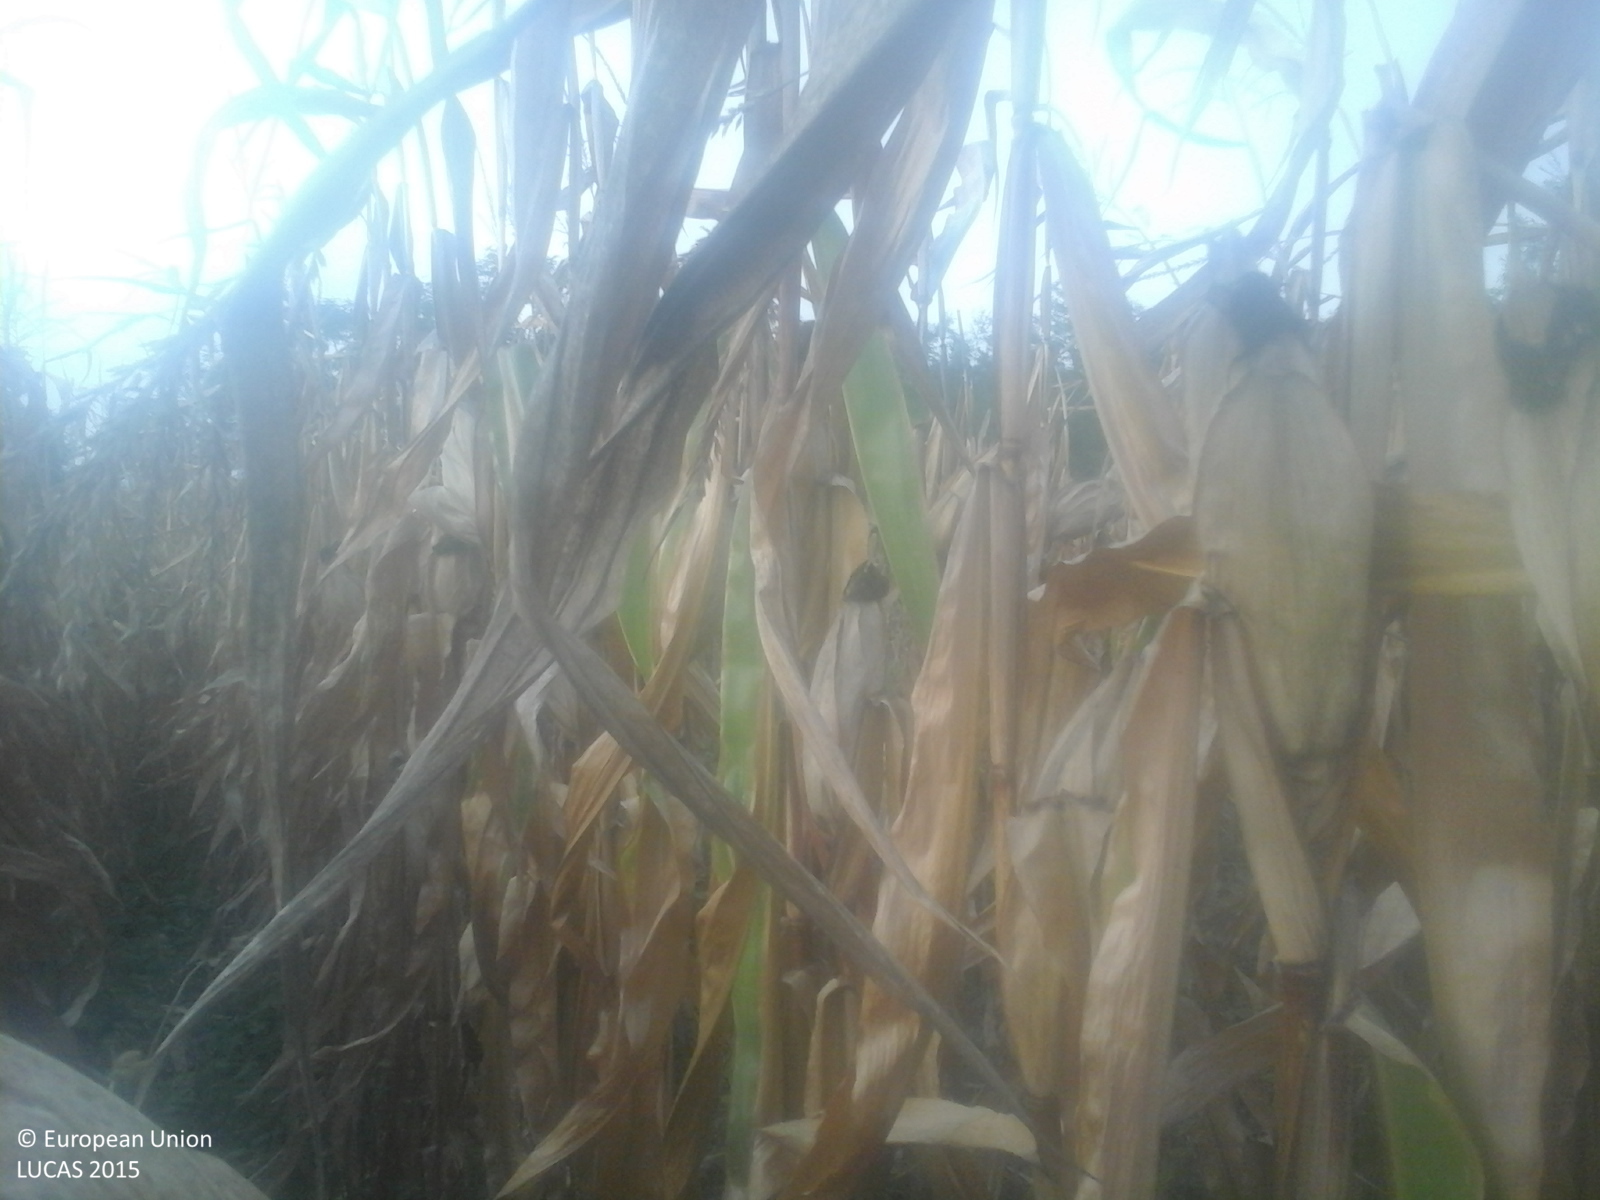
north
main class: Cropland
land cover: Maize
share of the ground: > 75 %
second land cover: Spontaneously vegetated surfaces
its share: 50 - 75 %
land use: Agriculture (excluding fallow land and kitchen gardens)
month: September
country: RO
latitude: 46.9190
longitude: 24.4410
